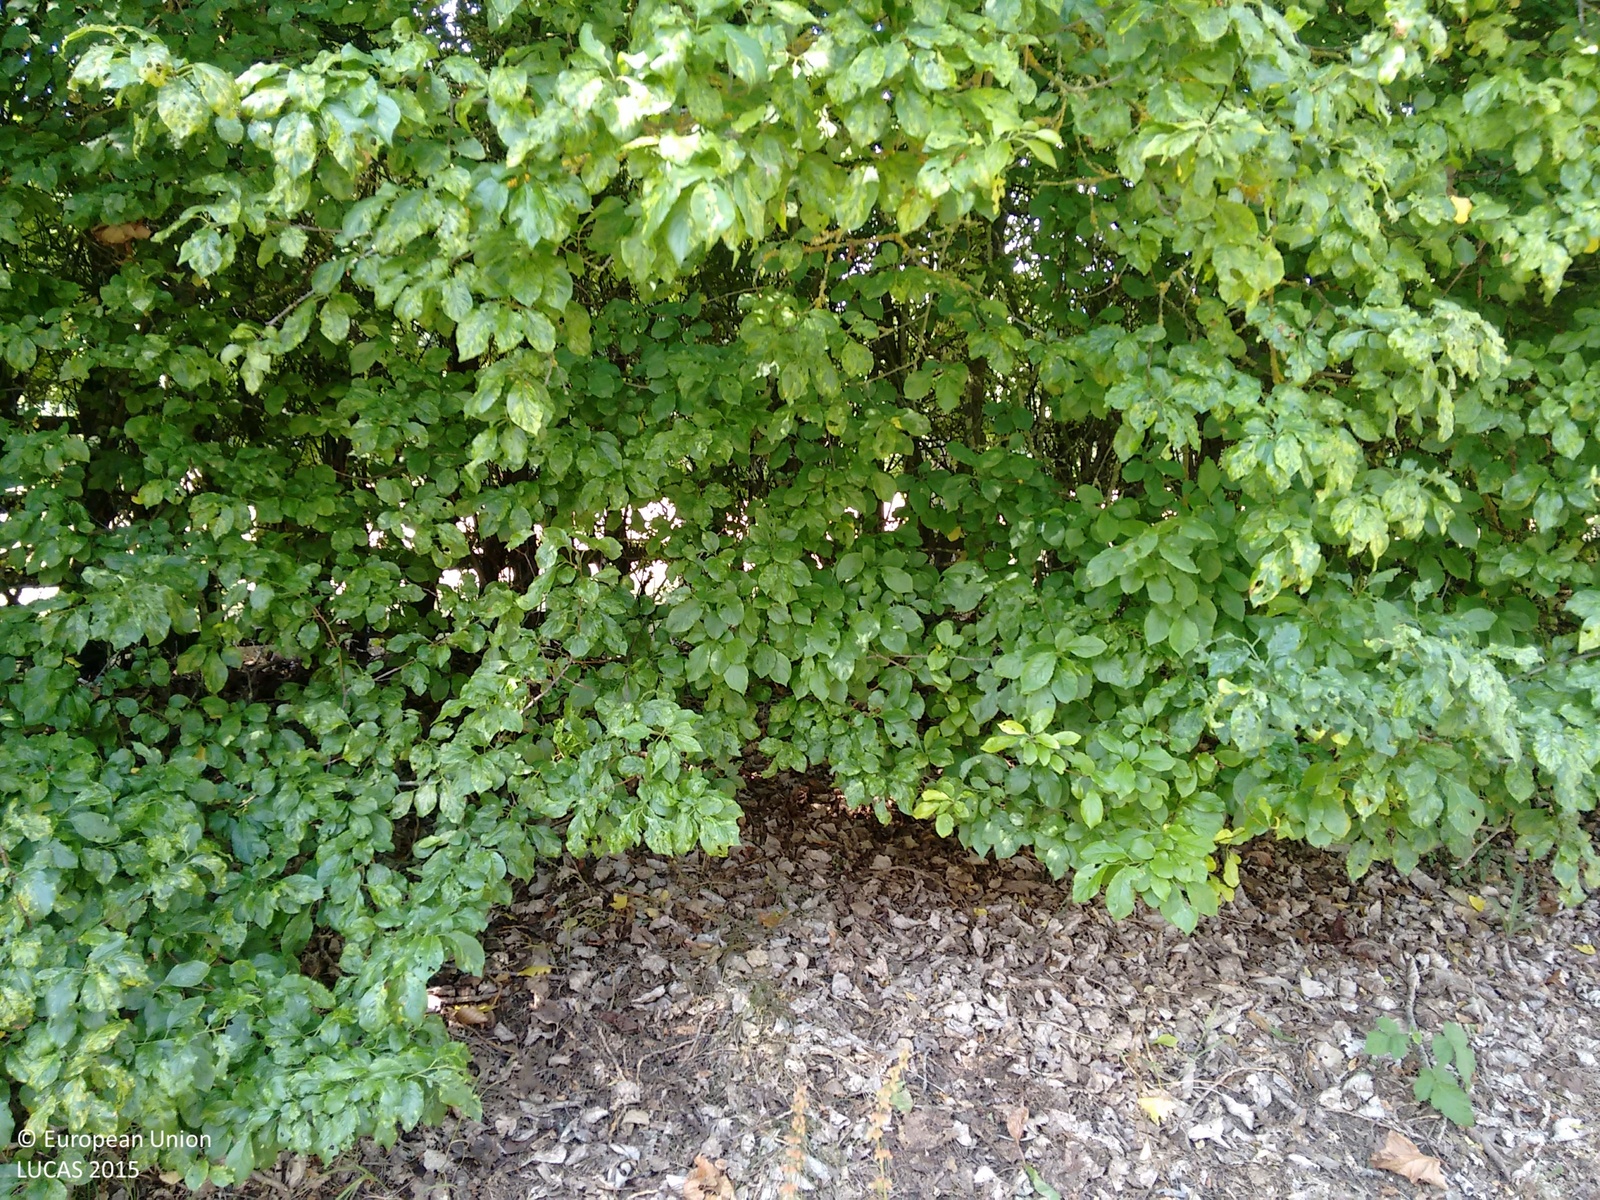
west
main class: Woodland
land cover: Broadleaved woodland
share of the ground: > 75 %
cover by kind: herbaceous plants 85 %, broadleaved forest trees 15 %
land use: Sport
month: July
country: GB
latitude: 52.5637
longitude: -0.2884
